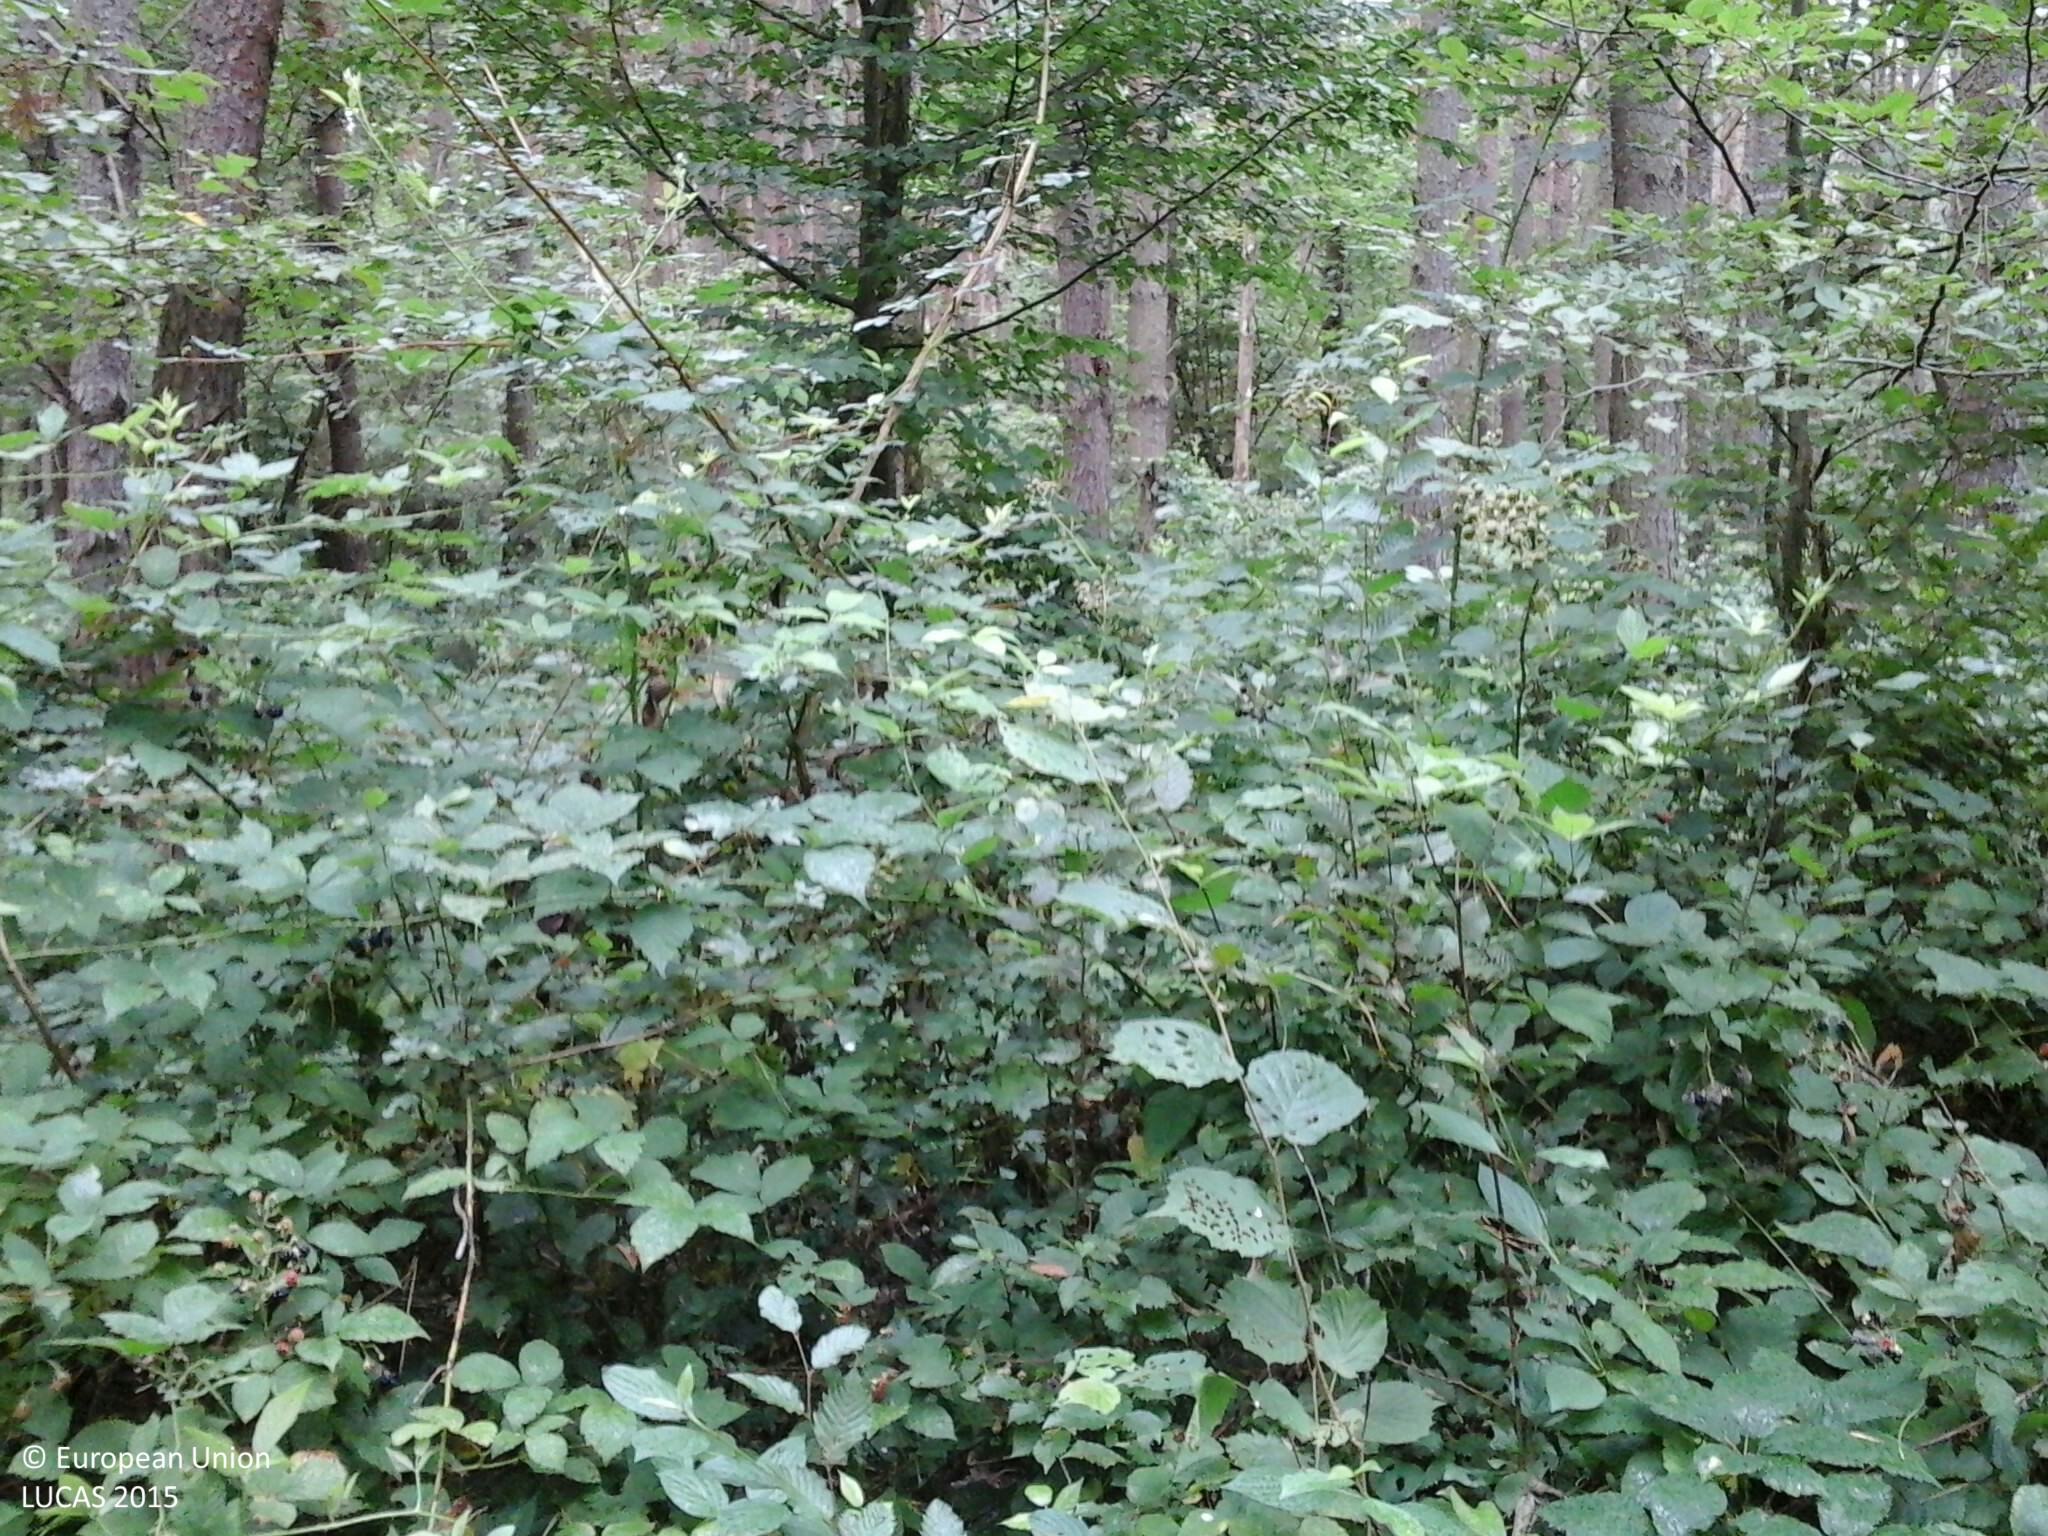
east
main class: Woodland
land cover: Other coniferous woodland
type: hemiboreal forest and nemoral coniferous forest and mixed broadleaved-coniferous forest
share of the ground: > 75 %
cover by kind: coniferous forest trees 60 %, shrubs 30 %, herbaceous plants 10 %
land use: Forestry
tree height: > 5 m
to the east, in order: Other coniferous woodland
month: July
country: HU
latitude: 46.7476
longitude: 16.5337
